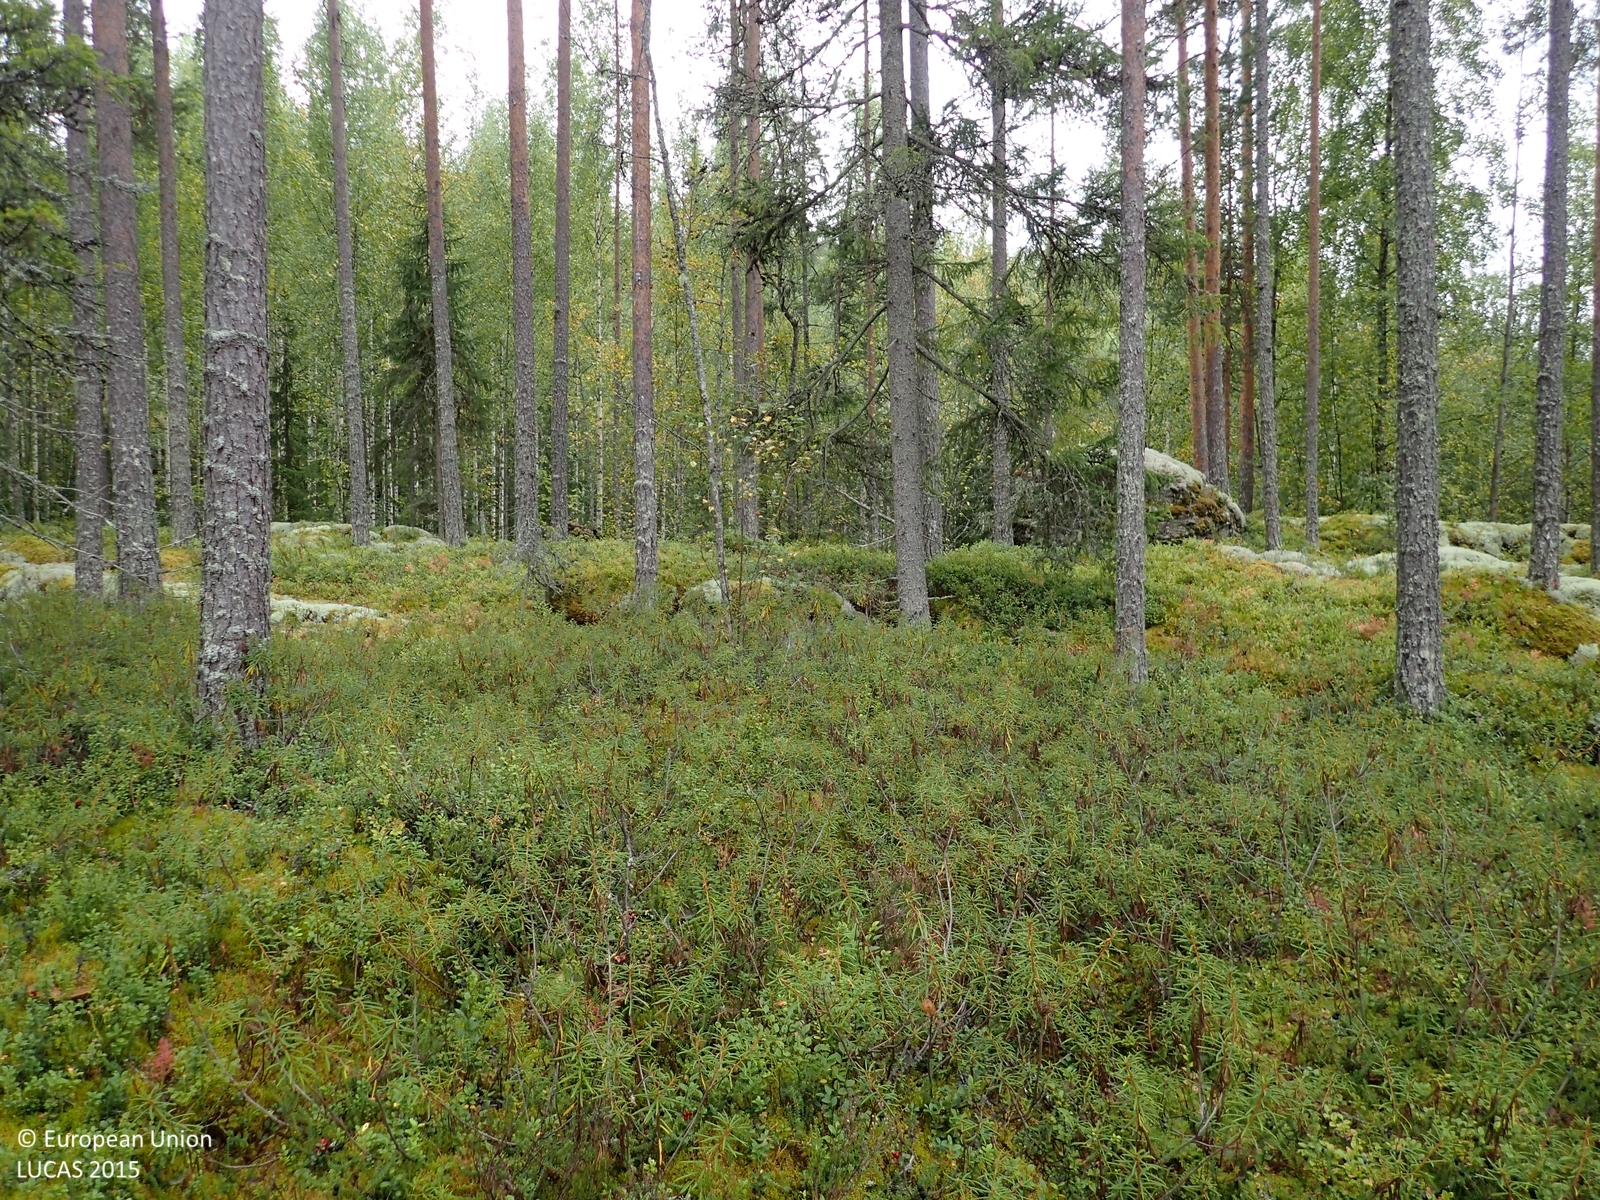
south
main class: Woodland
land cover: Pine dominated mixed woodland
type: boreal forest
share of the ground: 50 - 75 %
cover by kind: coniferous forest trees 45 %, shrubs 35 %, broadleaved forest trees 15 %, lichens and mosses 5 %
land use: Forestry
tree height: > 5 m
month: September
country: FI
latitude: 63.1122
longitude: 26.0339
